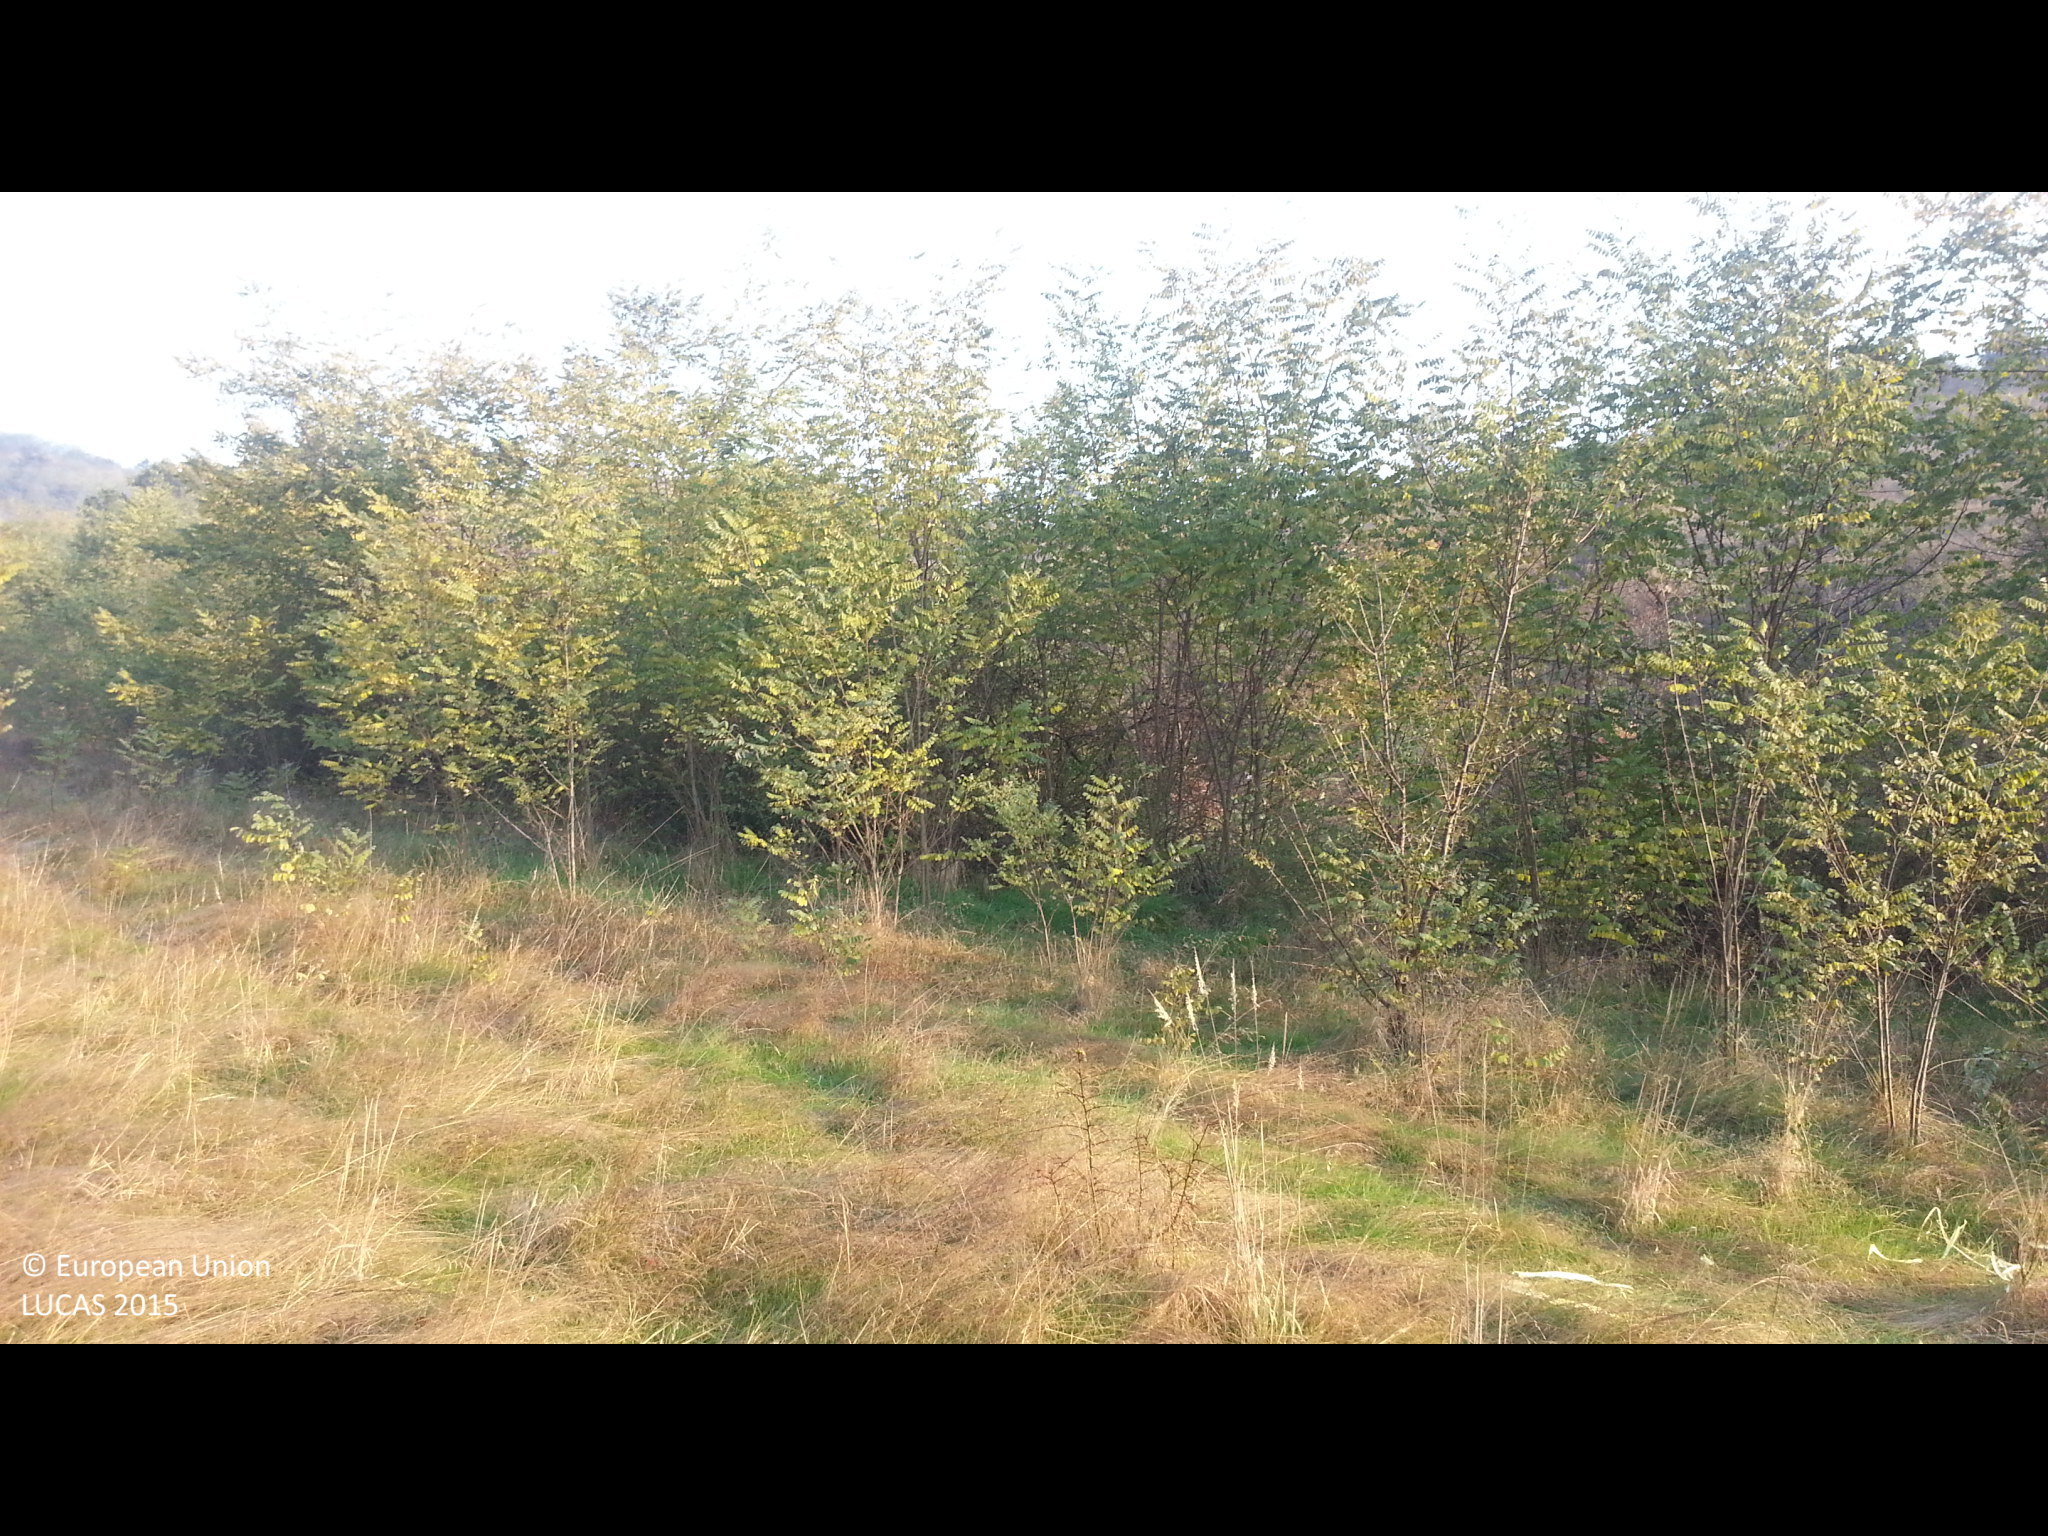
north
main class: Grassland
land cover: Grassland without tree/shrub cover
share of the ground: > 75 %
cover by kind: herbaceous plants 100 %
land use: Agriculture (excluding fallow land and kitchen gardens)
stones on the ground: 10 - 25 %
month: November
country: BG
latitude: 42.9536
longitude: 23.7596
